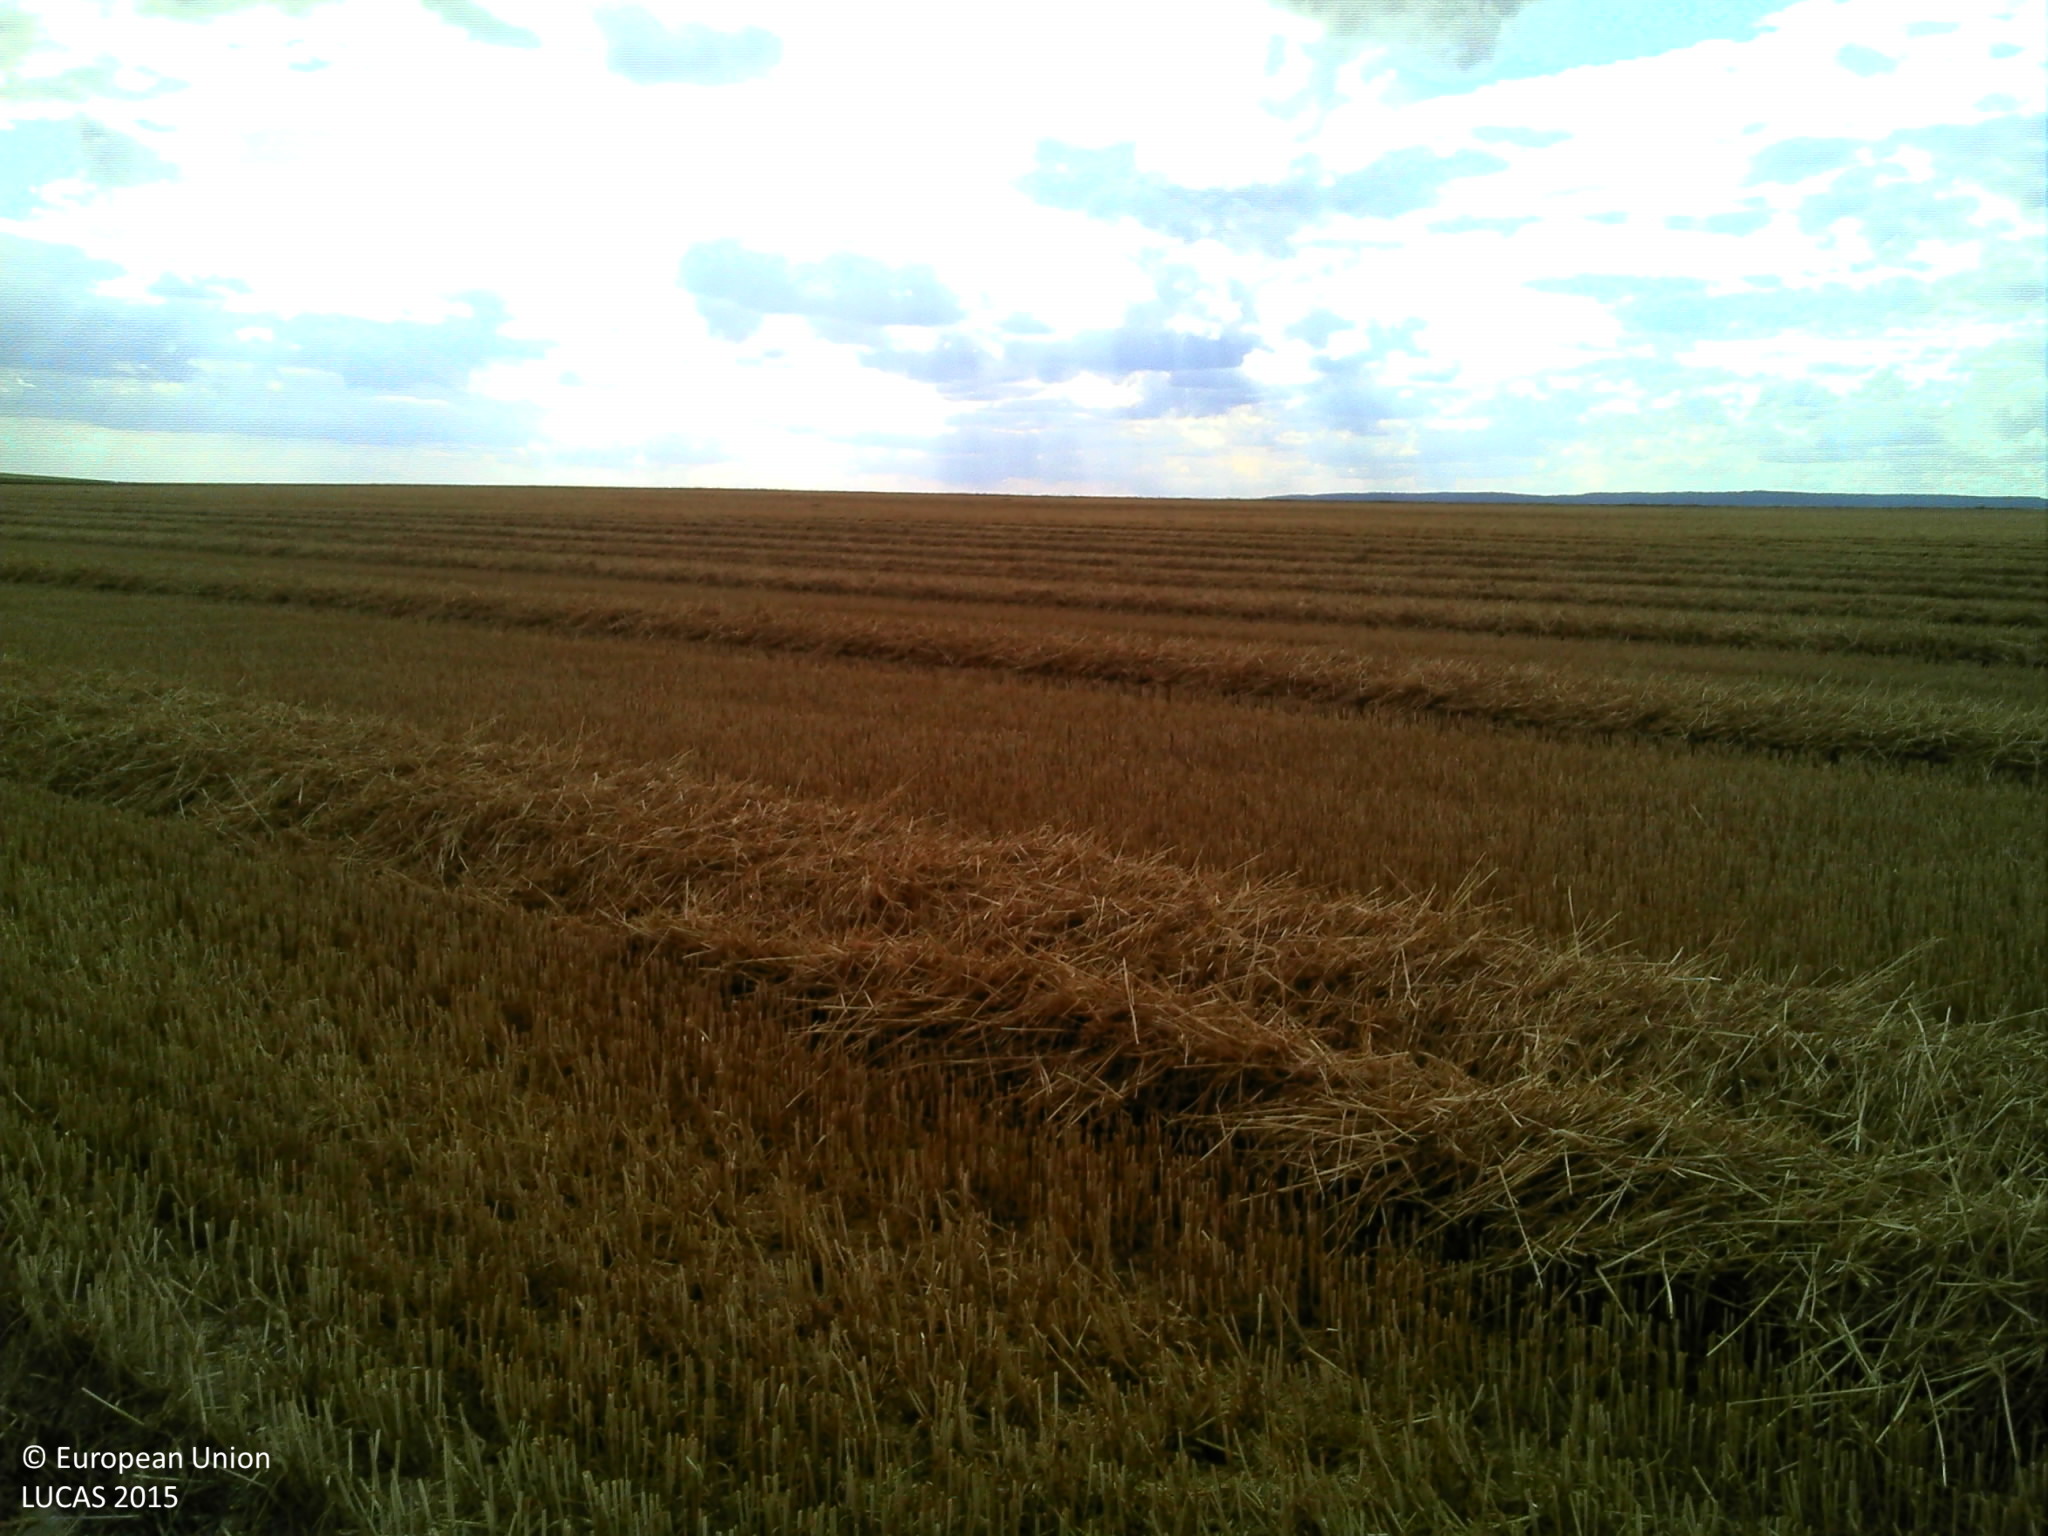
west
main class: Cropland
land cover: Common wheat
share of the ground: > 75 %
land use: Agriculture (excluding fallow land and kitchen gardens)
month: July
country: FR
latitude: 49.0868
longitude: 4.3136
